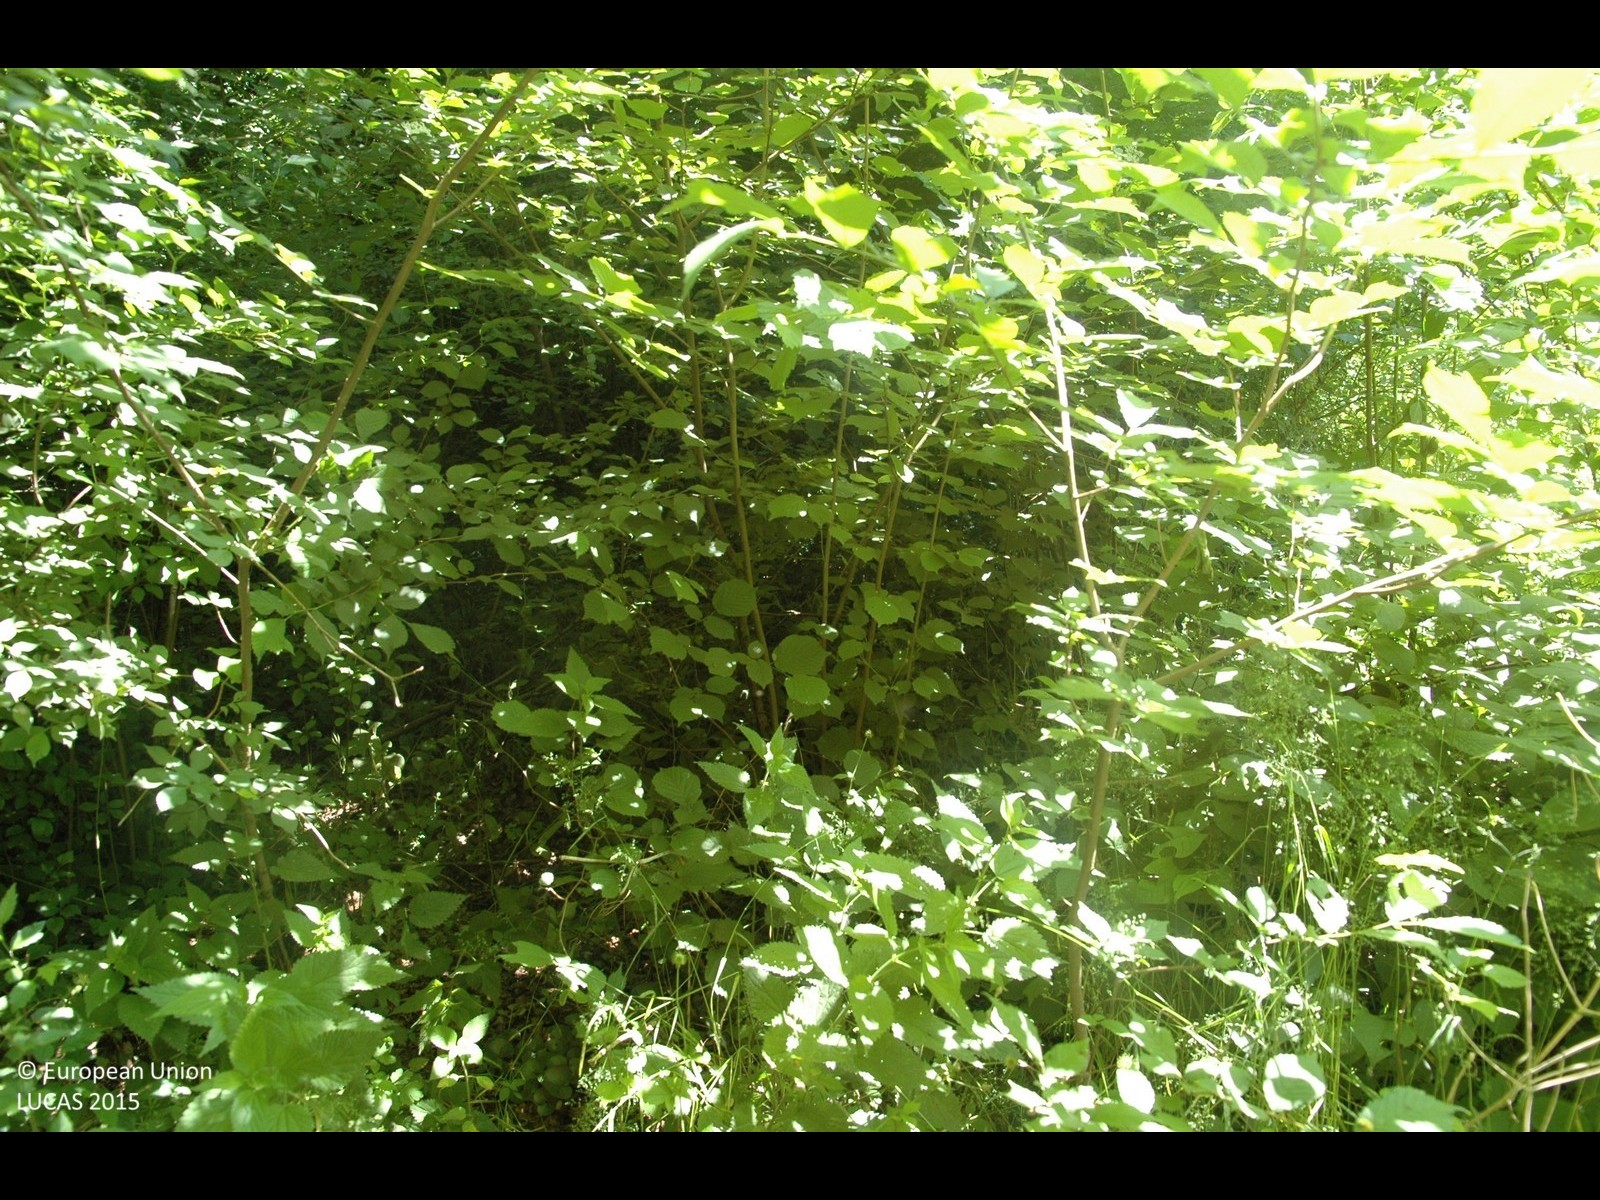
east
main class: Woodland
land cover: Broadleaved woodland
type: beech forest
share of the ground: > 75 %
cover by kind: broadleaved forest trees 90 %, shrubs 5 %, herbaceous plants 5 %
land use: Forestry
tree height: > 5 m
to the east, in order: Broadleaved woodland; Grassland without tree/shrub cover; Broadleaved woodland; Grassland without tree/shrub cover; Artificial constructions in urban areas
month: May
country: HR
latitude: 46.5238
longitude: 16.3493
